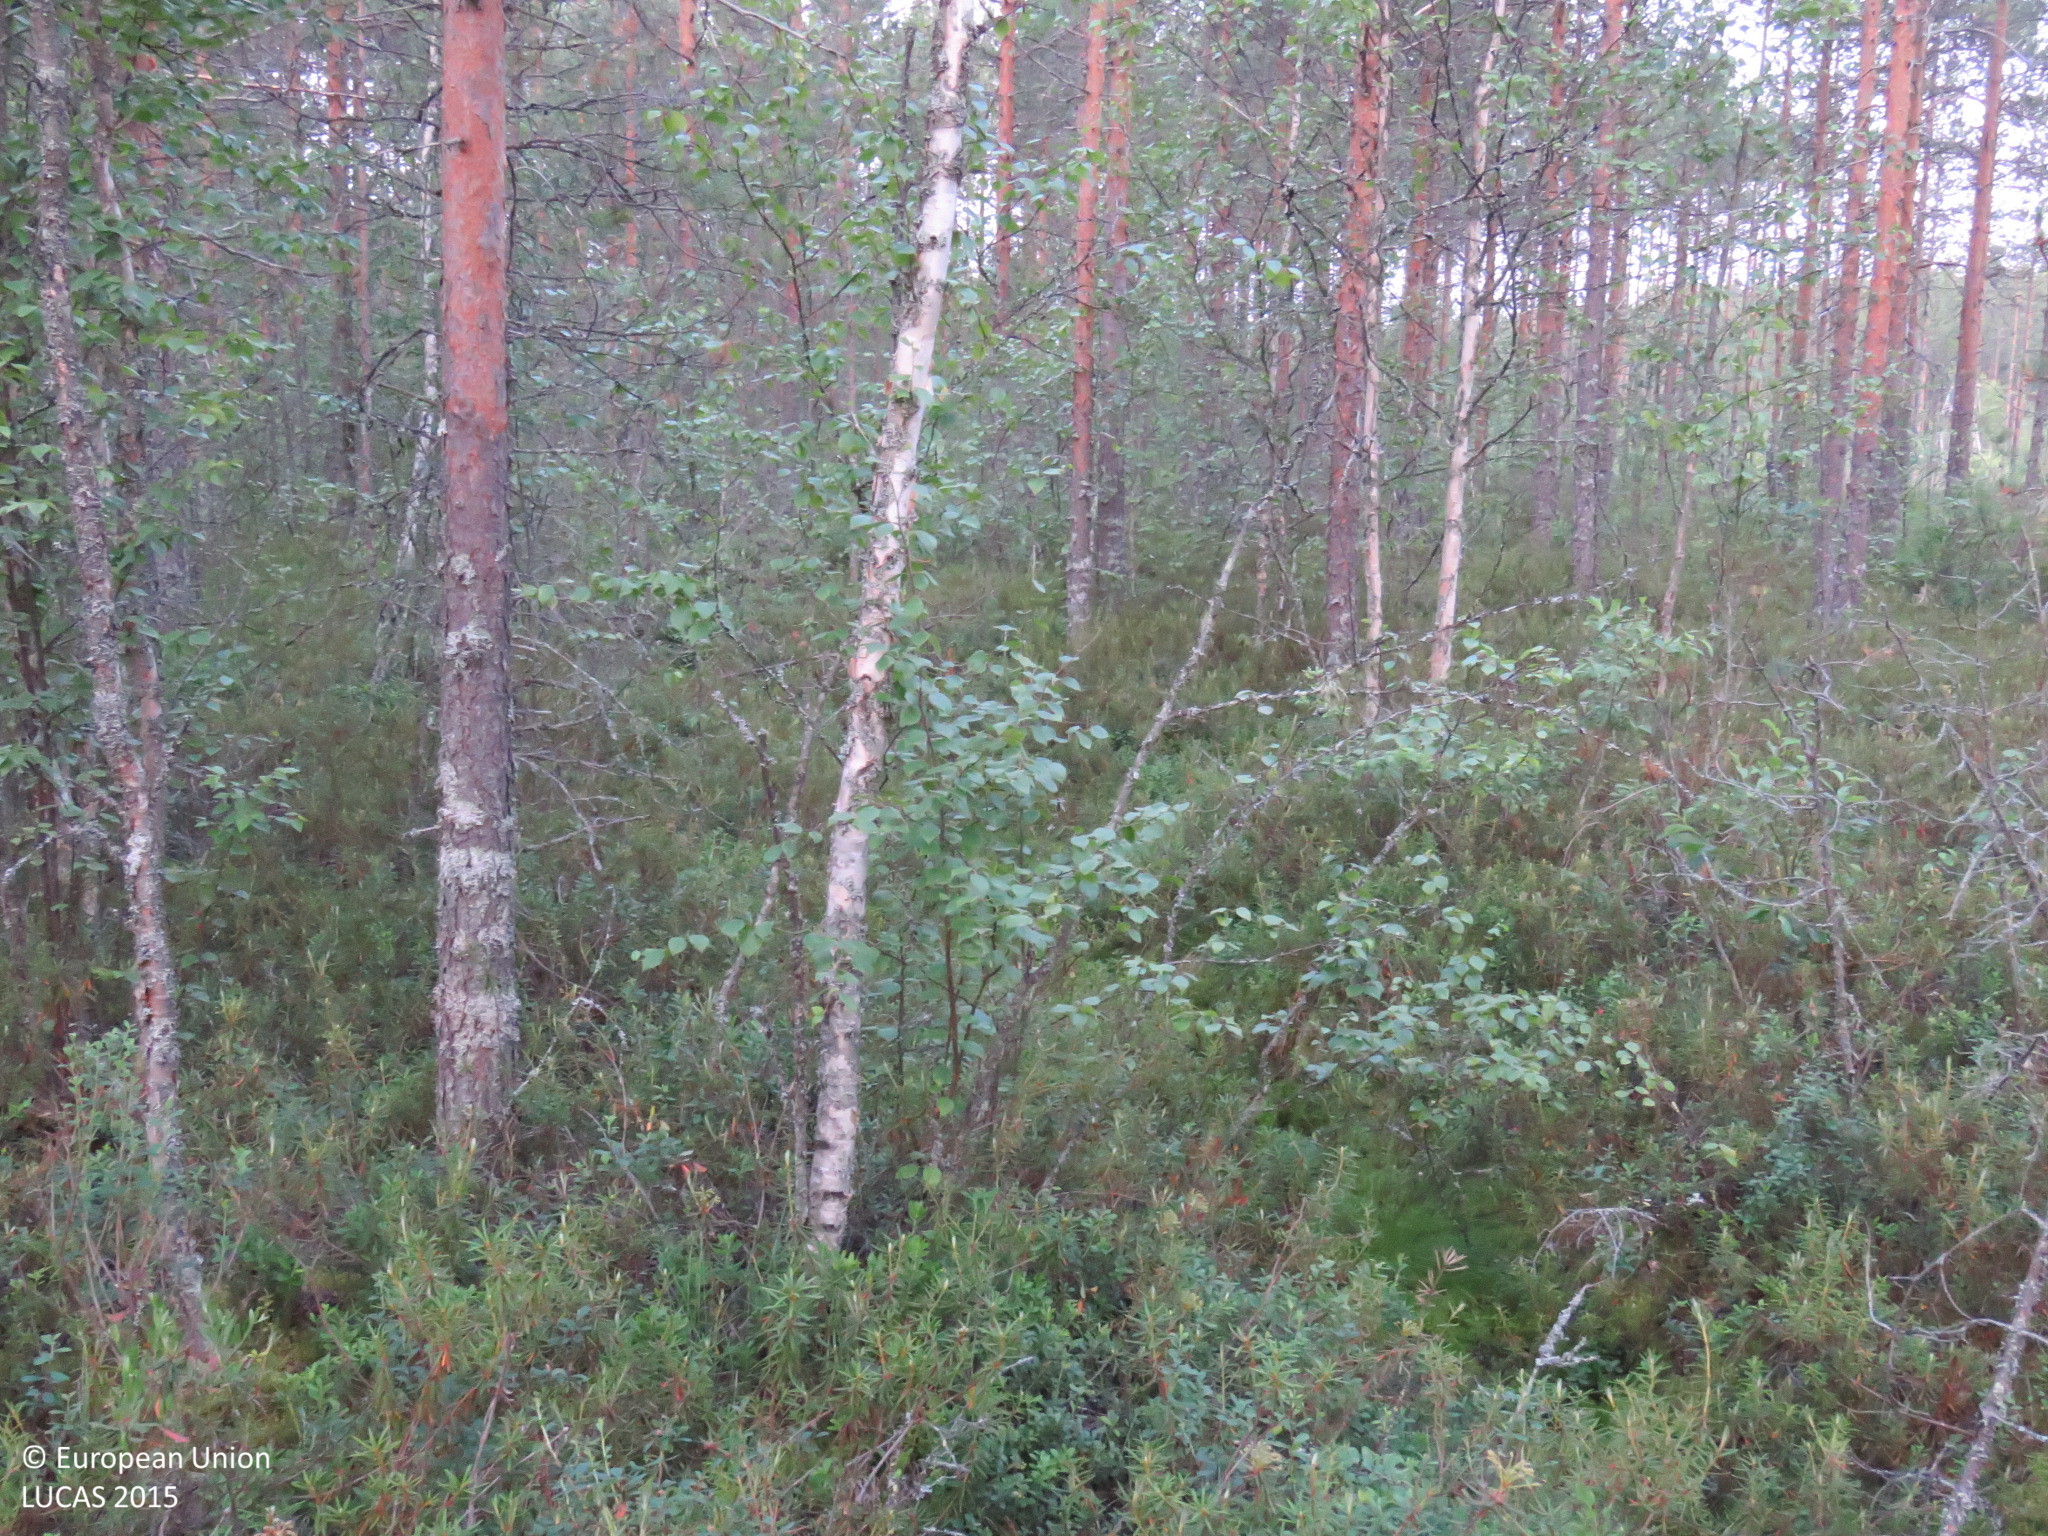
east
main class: Woodland
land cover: Pine dominated coniferous woodland
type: boreal forest
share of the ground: > 75 %
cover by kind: coniferous forest trees 80 %, broadleaved forest trees 10 %, shrubs 10 %
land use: Forestry
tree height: > 5 m
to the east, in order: Pine dominated coniferous woodland; Ditches and canals; Pine dominated coniferous woodland; Ditches and canals; Grass margins; Paved roads, cycling and walking lanes; Grass margins; Ditches and canals; Abandoned hedges; Pine dominated mixed woodland; Ditches and canals; Pine dominated coniferous woodland; Other mixed woodland; Ditches and canals; Other mixed woodland; Pine dominated coniferous woodland
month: July
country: FI
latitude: 64.7684
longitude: 26.3165
